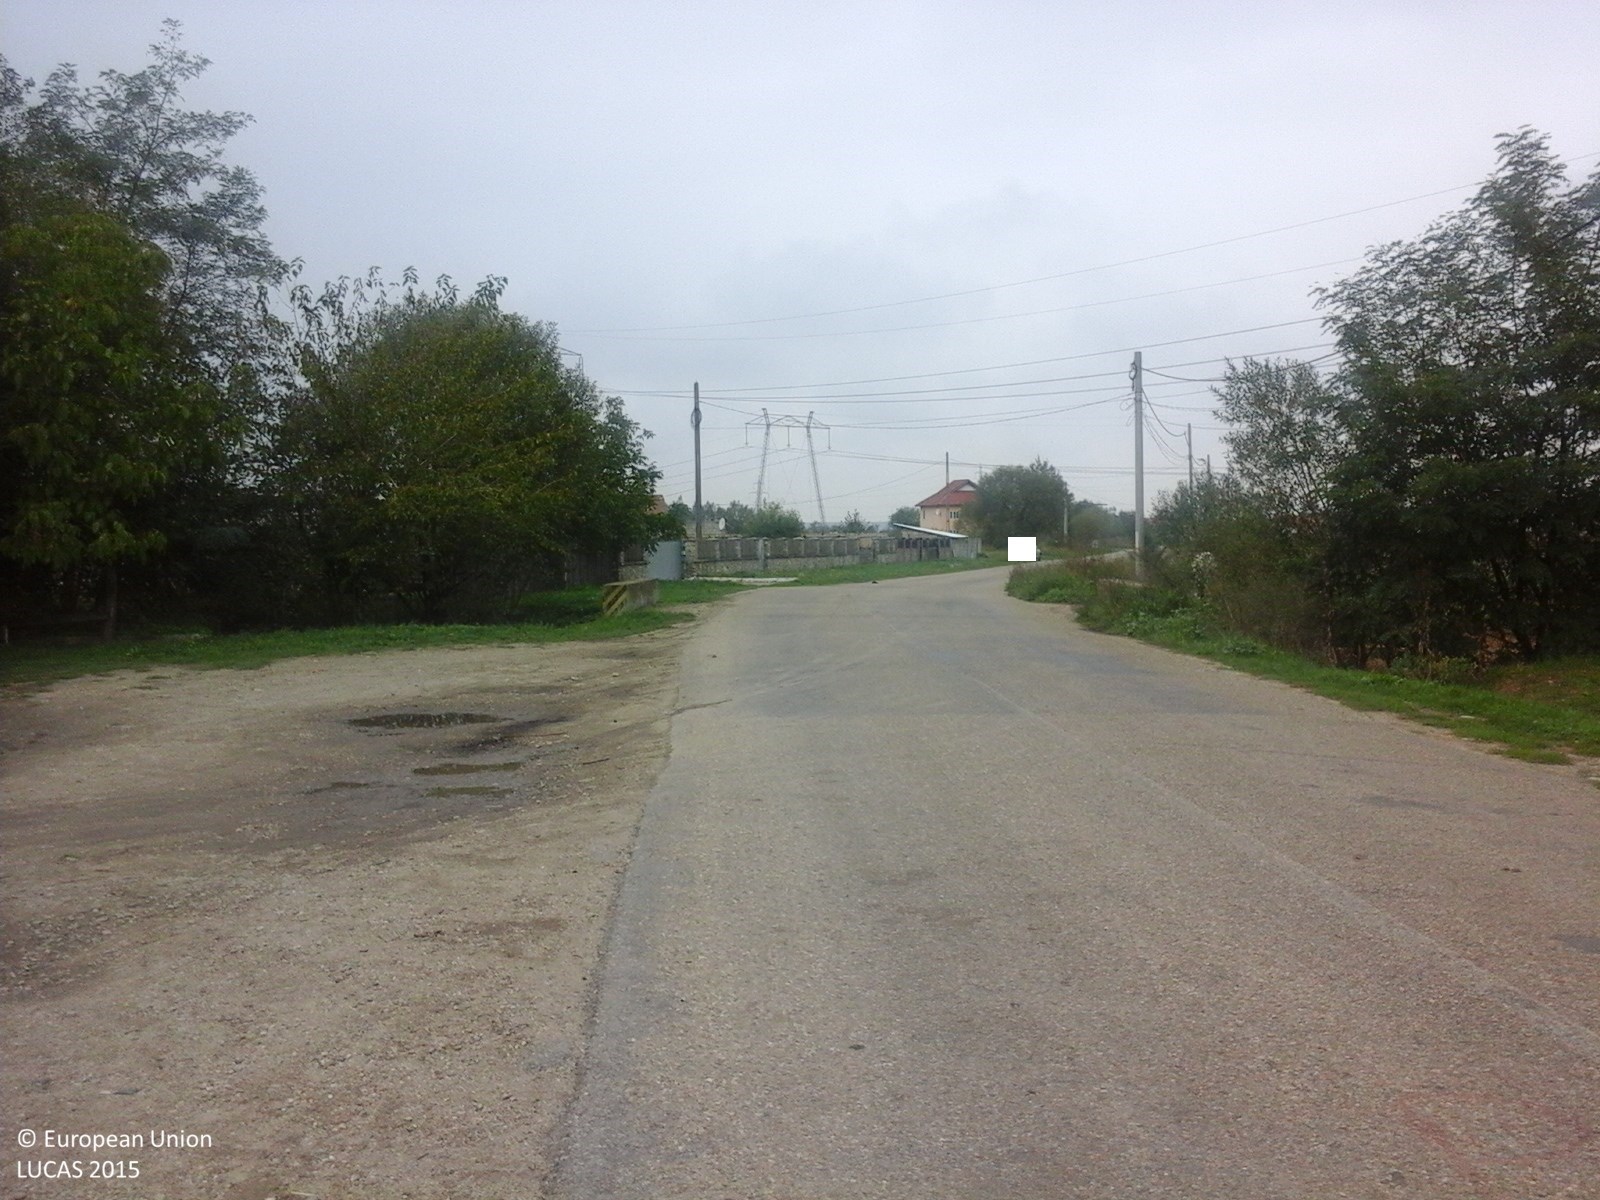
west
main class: Cropland
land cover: Tomatoes
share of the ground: > 75 %
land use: Kitchen garden
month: September
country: RO
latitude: 44.9829
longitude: 23.3326
